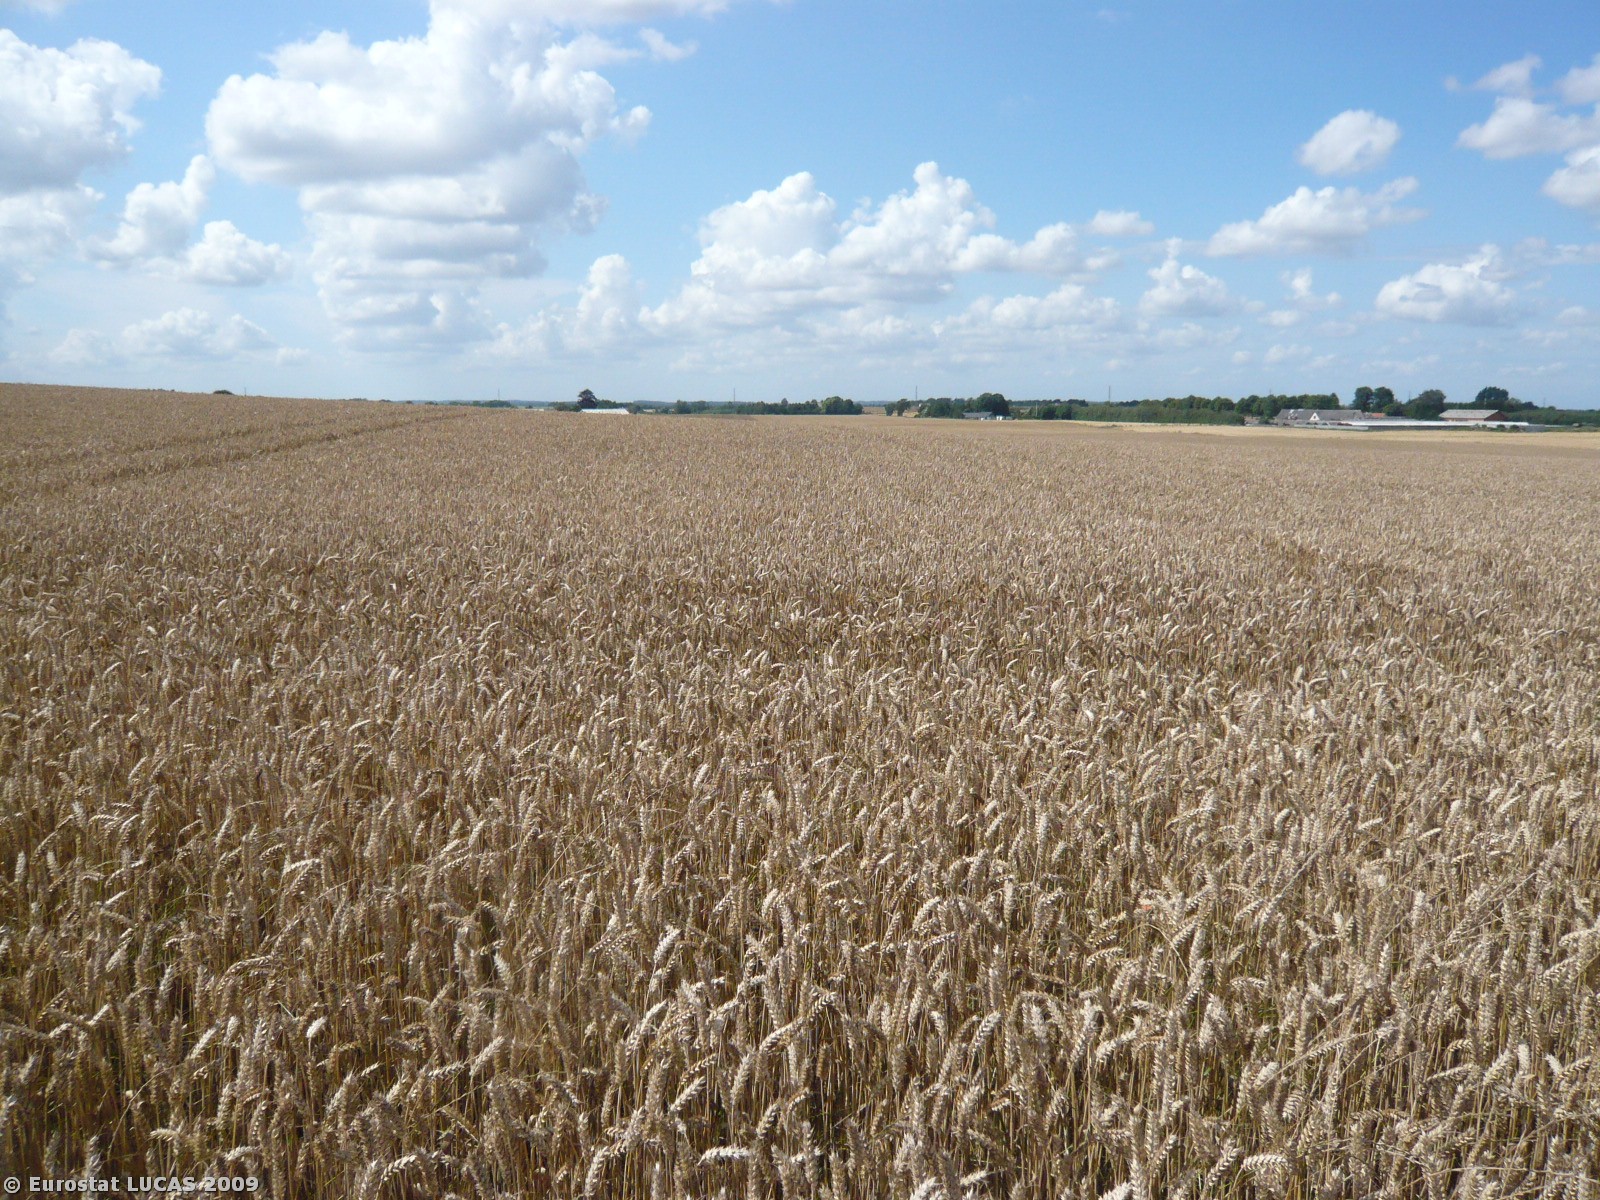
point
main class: Cropland
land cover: Common wheat
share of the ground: > 75 %
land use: Agriculture (excluding fallow land and kitchen gardens)
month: July
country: DK
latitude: 55.5596
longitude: 12.0753
